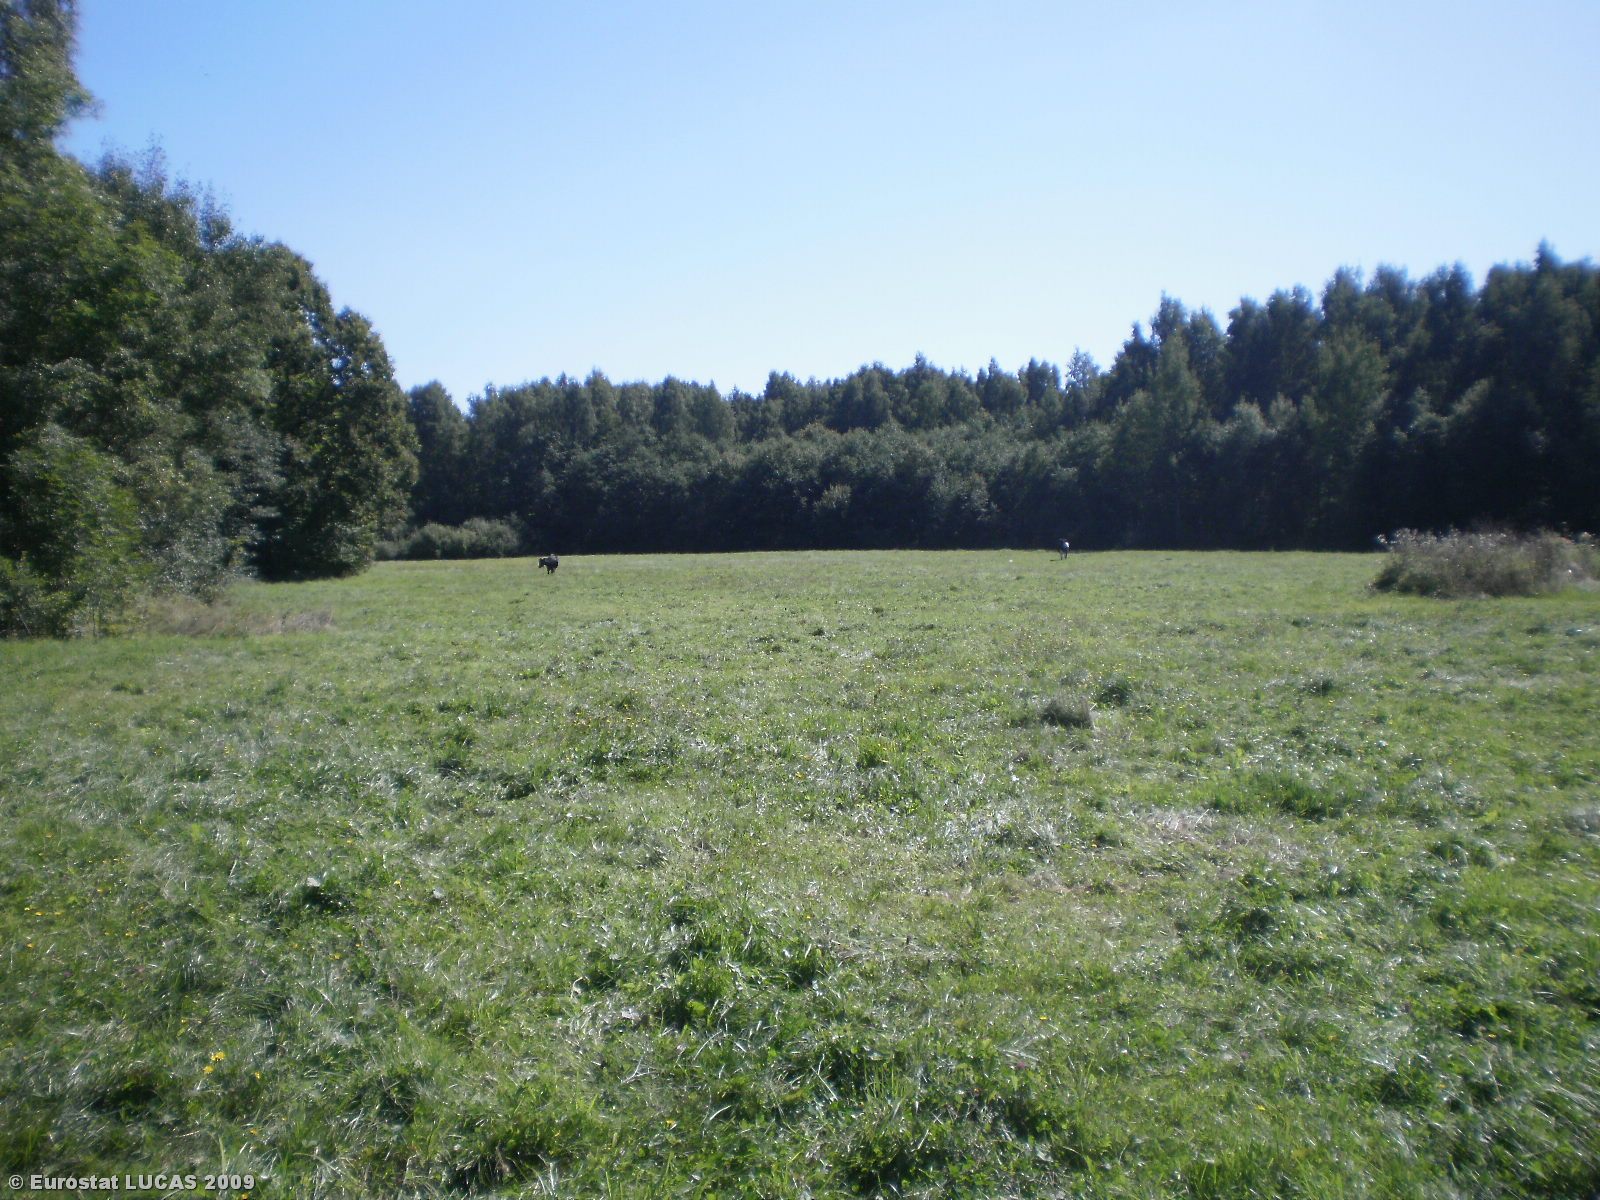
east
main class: Grassland
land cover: Grassland without tree/shrub cover
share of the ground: > 75 %
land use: Agriculture (excluding fallow land and kitchen gardens)
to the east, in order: Grassland without tree/shrub cover; Broadleaved woodland; Grassland without tree/shrub cover; Mixed woodland
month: August
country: LT
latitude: 54.8018
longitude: 24.7146
